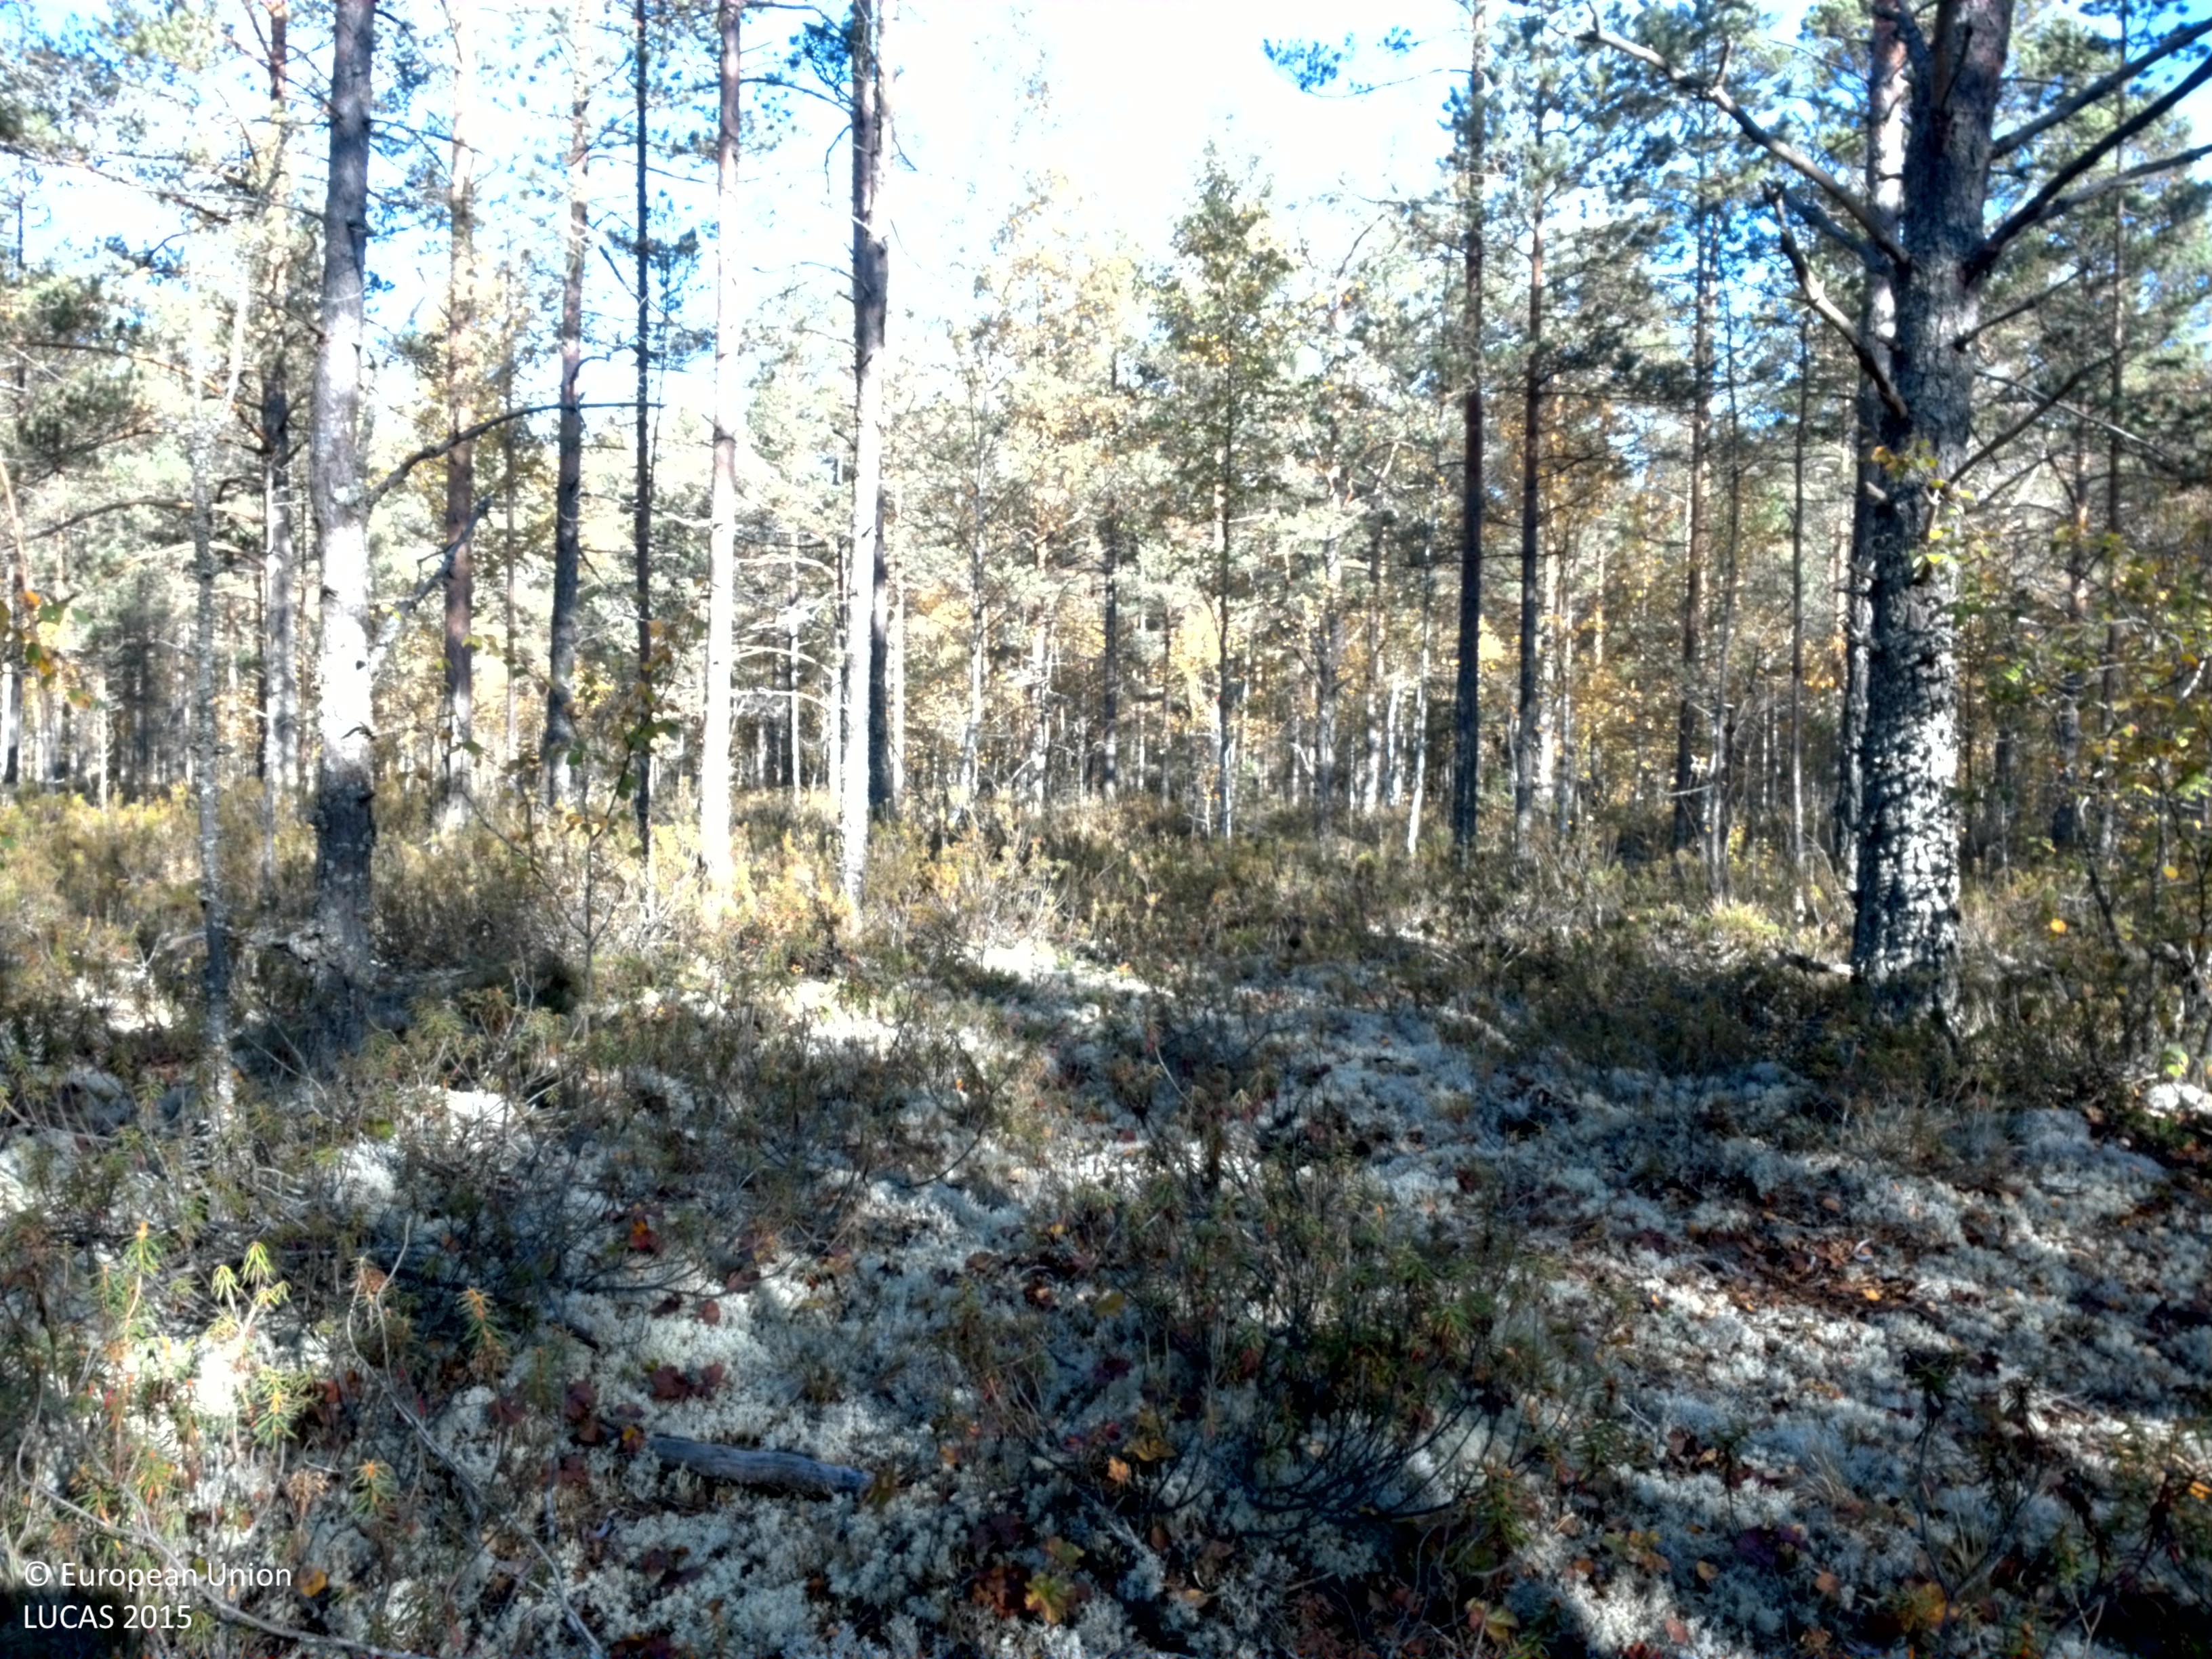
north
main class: Woodland
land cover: Pine dominated coniferous woodland
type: boreal forest
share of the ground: 50 - 75 %
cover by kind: coniferous forest trees 55 %, lichens and mosses 15 %, broadleaved forest trees 10 %, shrubs 10 %, herbaceous plants 10 %
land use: Forestry
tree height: > 5 m
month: September
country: SE
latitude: 59.9964
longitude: 16.4626
